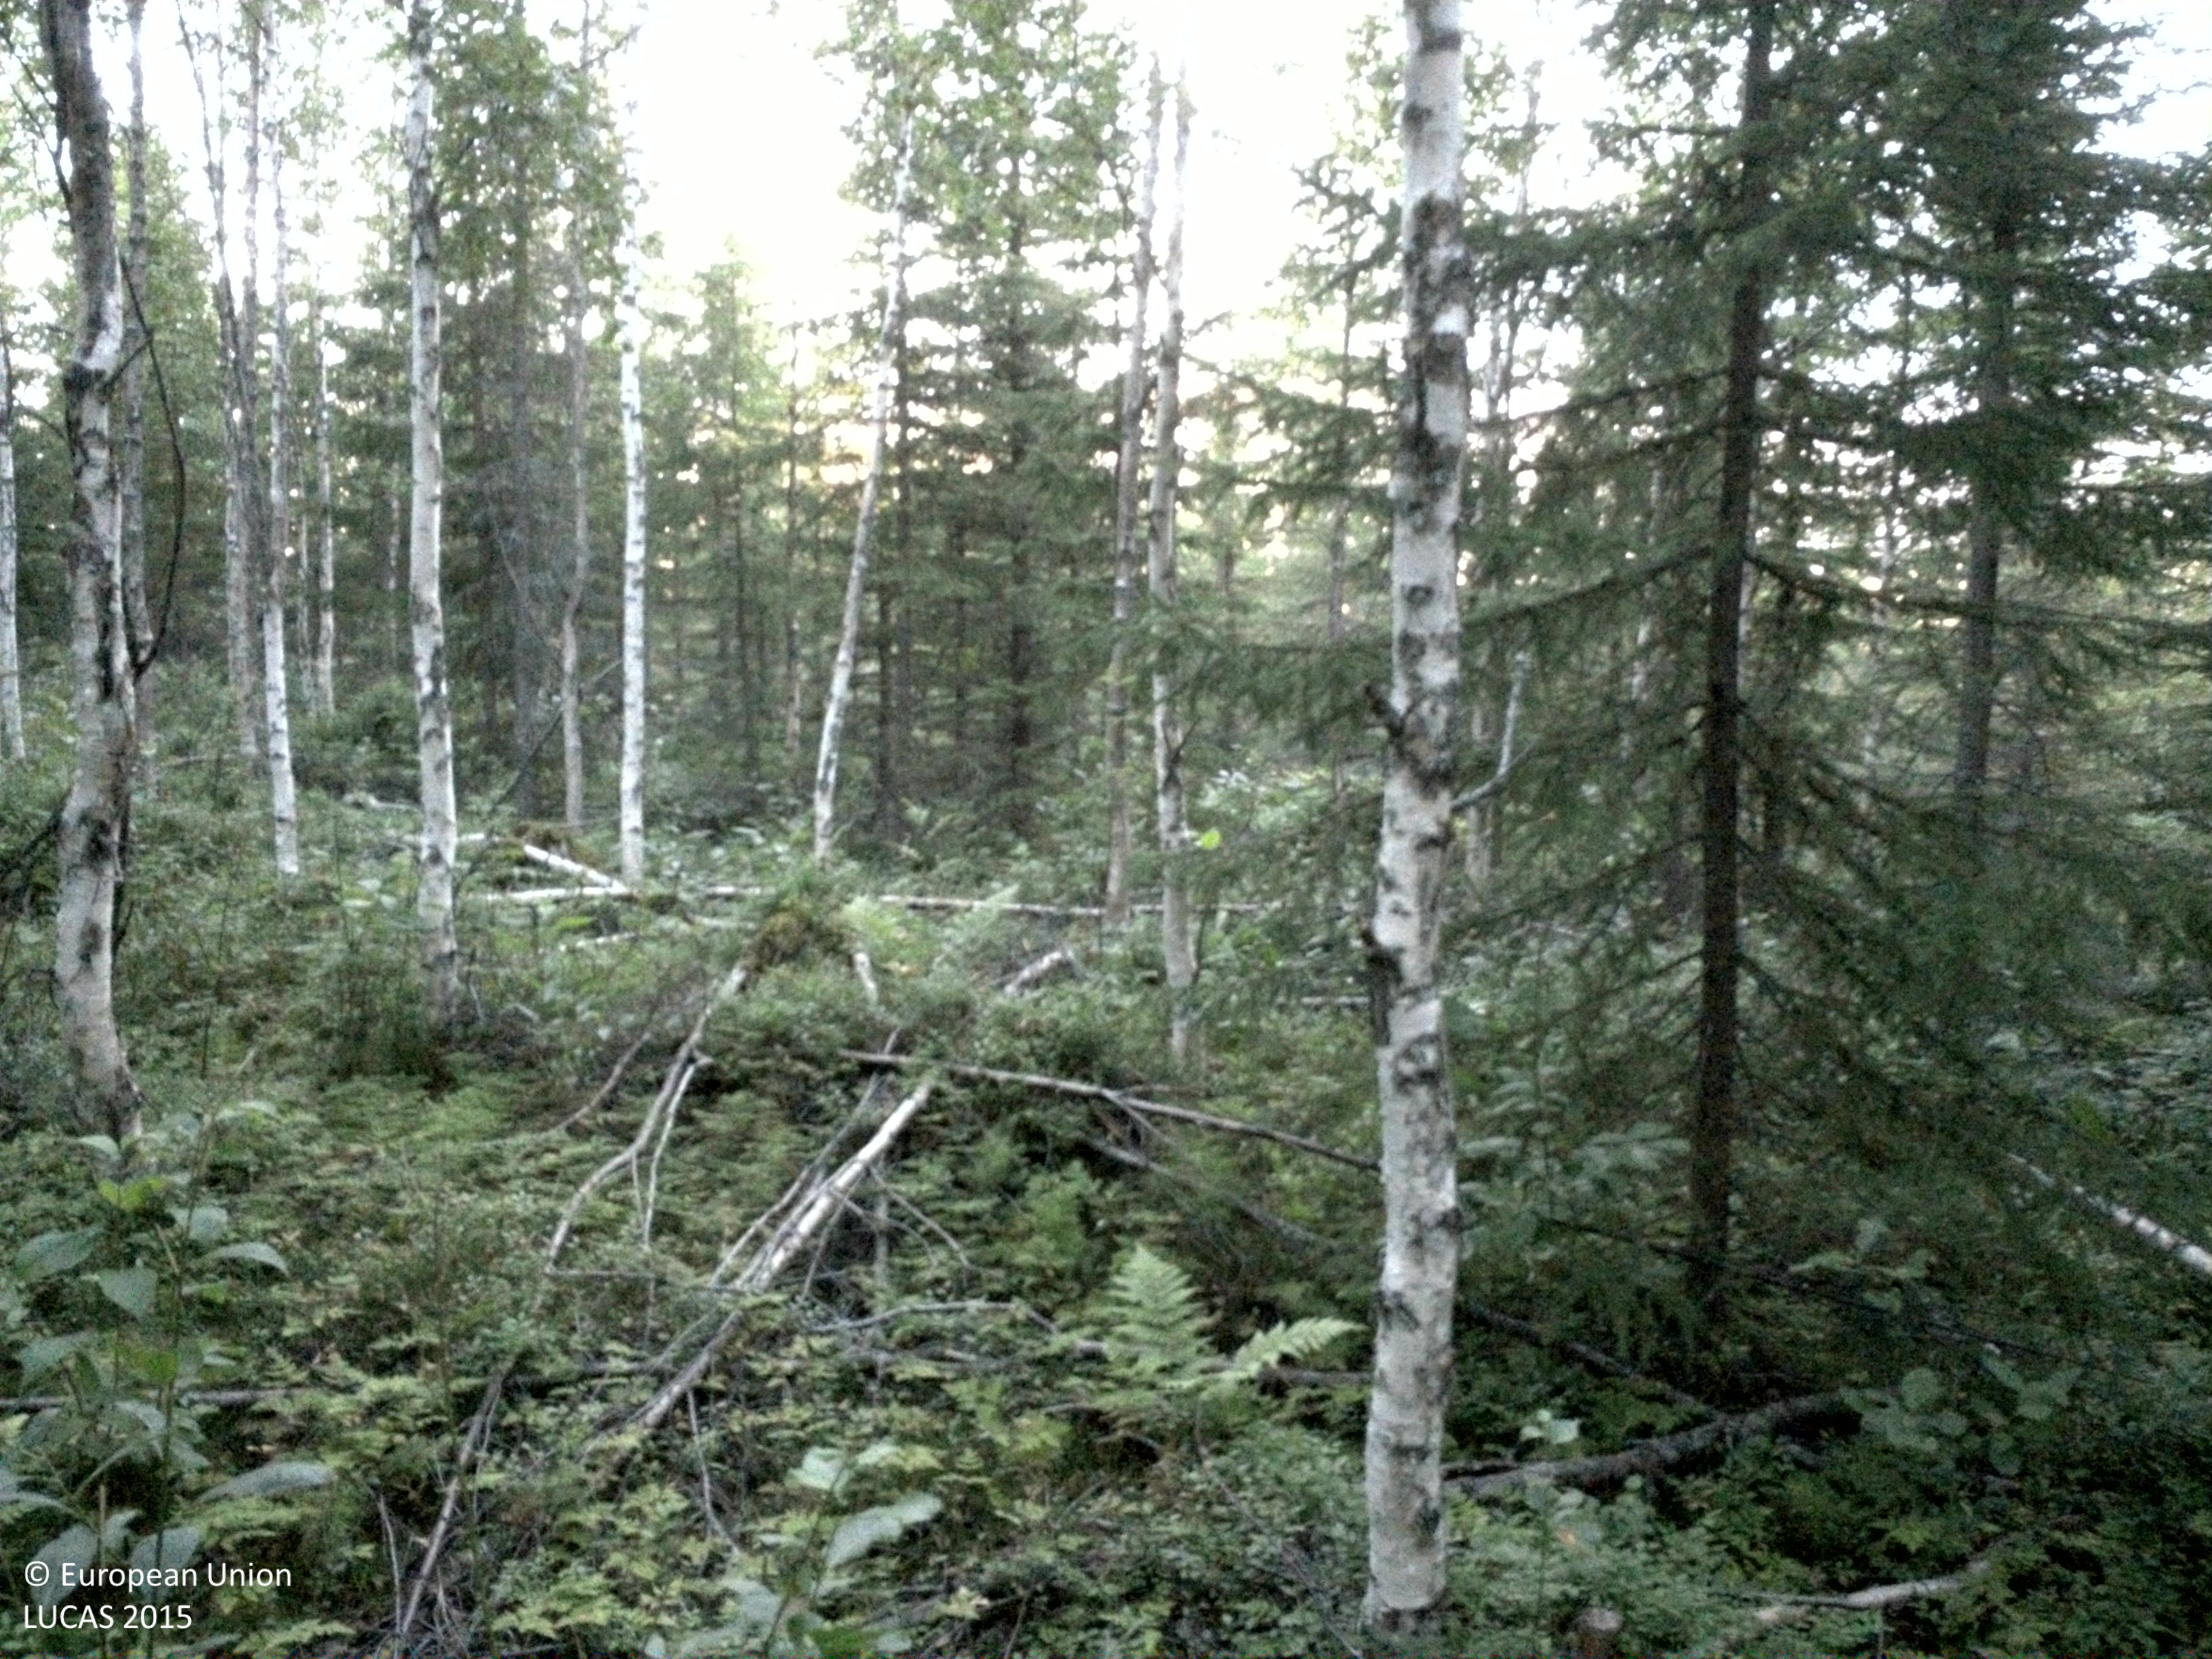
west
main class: Woodland
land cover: Spruce dominated mixed woodland
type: boreal forest
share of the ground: 50 - 75 %
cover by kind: coniferous forest trees 45 %, shrubs 20 %, herbaceous plants 20 %, broadleaved forest trees 15 %
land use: Forestry
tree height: > 5 m
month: August
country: SE
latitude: 64.3575
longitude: 18.7307
